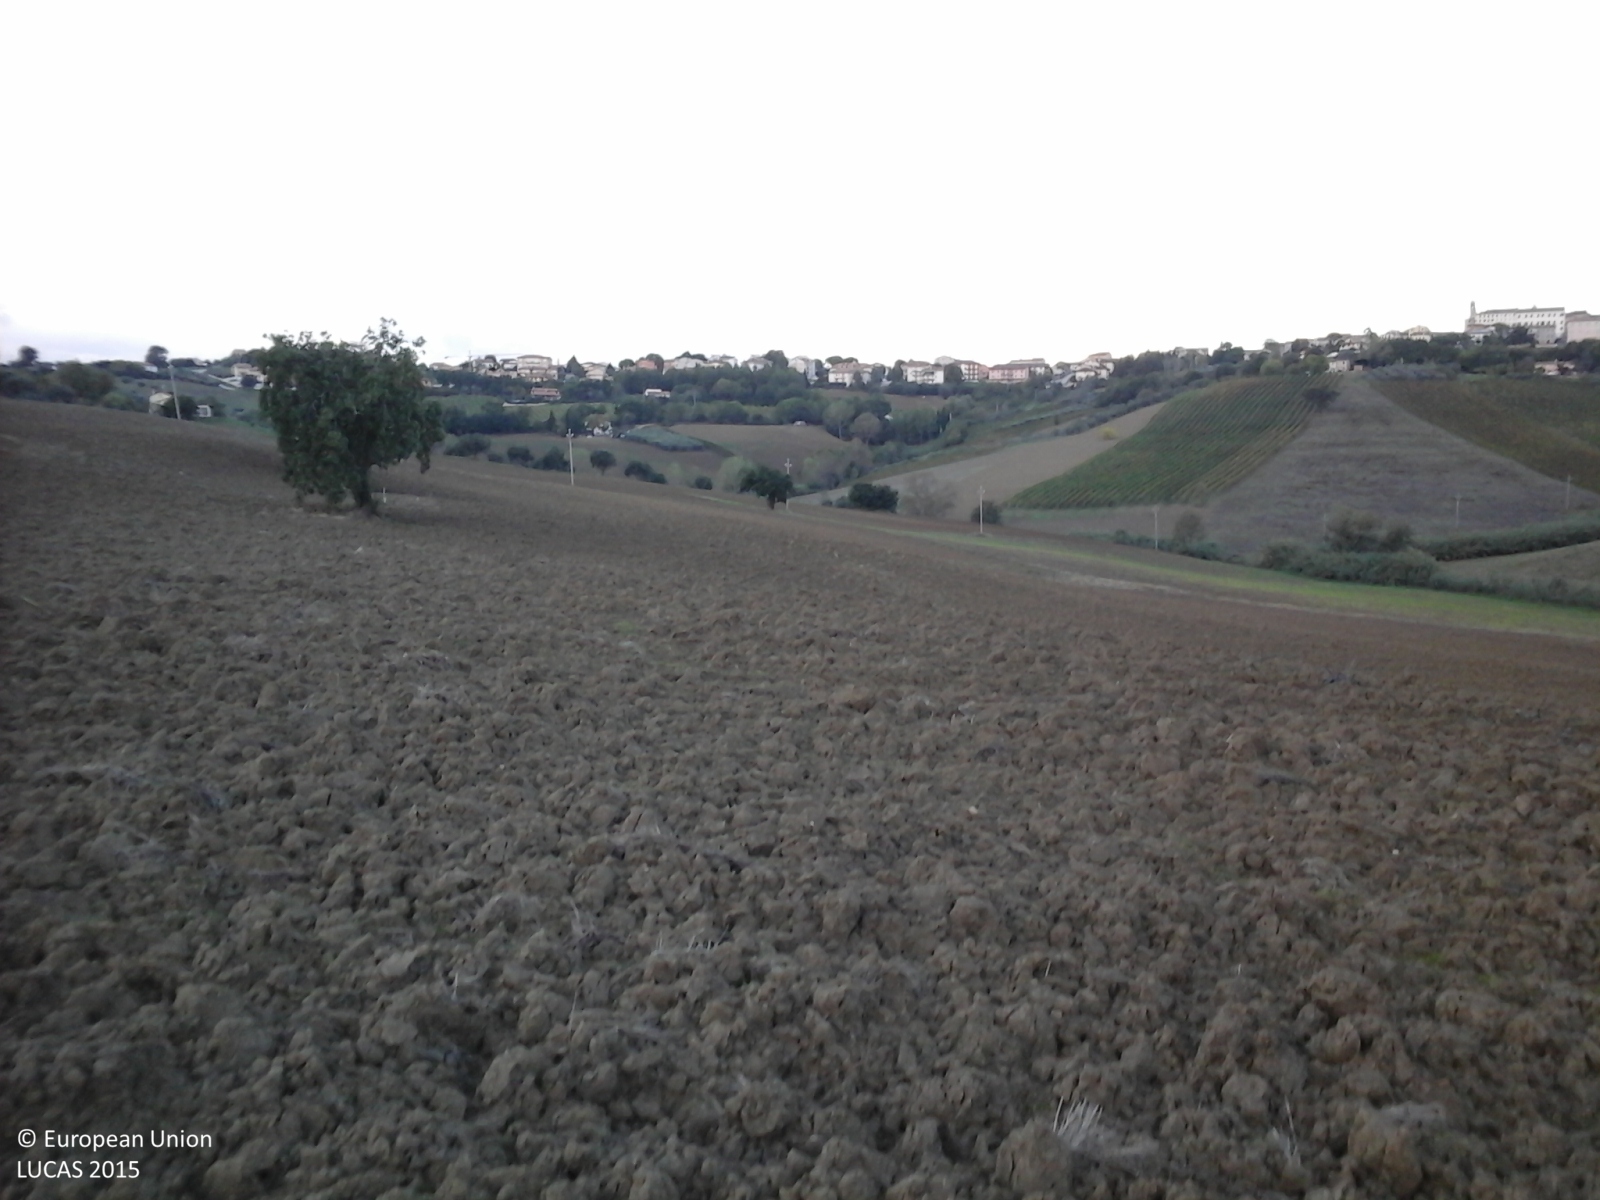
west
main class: Cropland
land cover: Durum wheat
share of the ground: < 10 %
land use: Agriculture (excluding fallow land and kitchen gardens)
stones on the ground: < 10 %
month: October
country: IT
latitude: 43.5963
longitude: 13.2252
